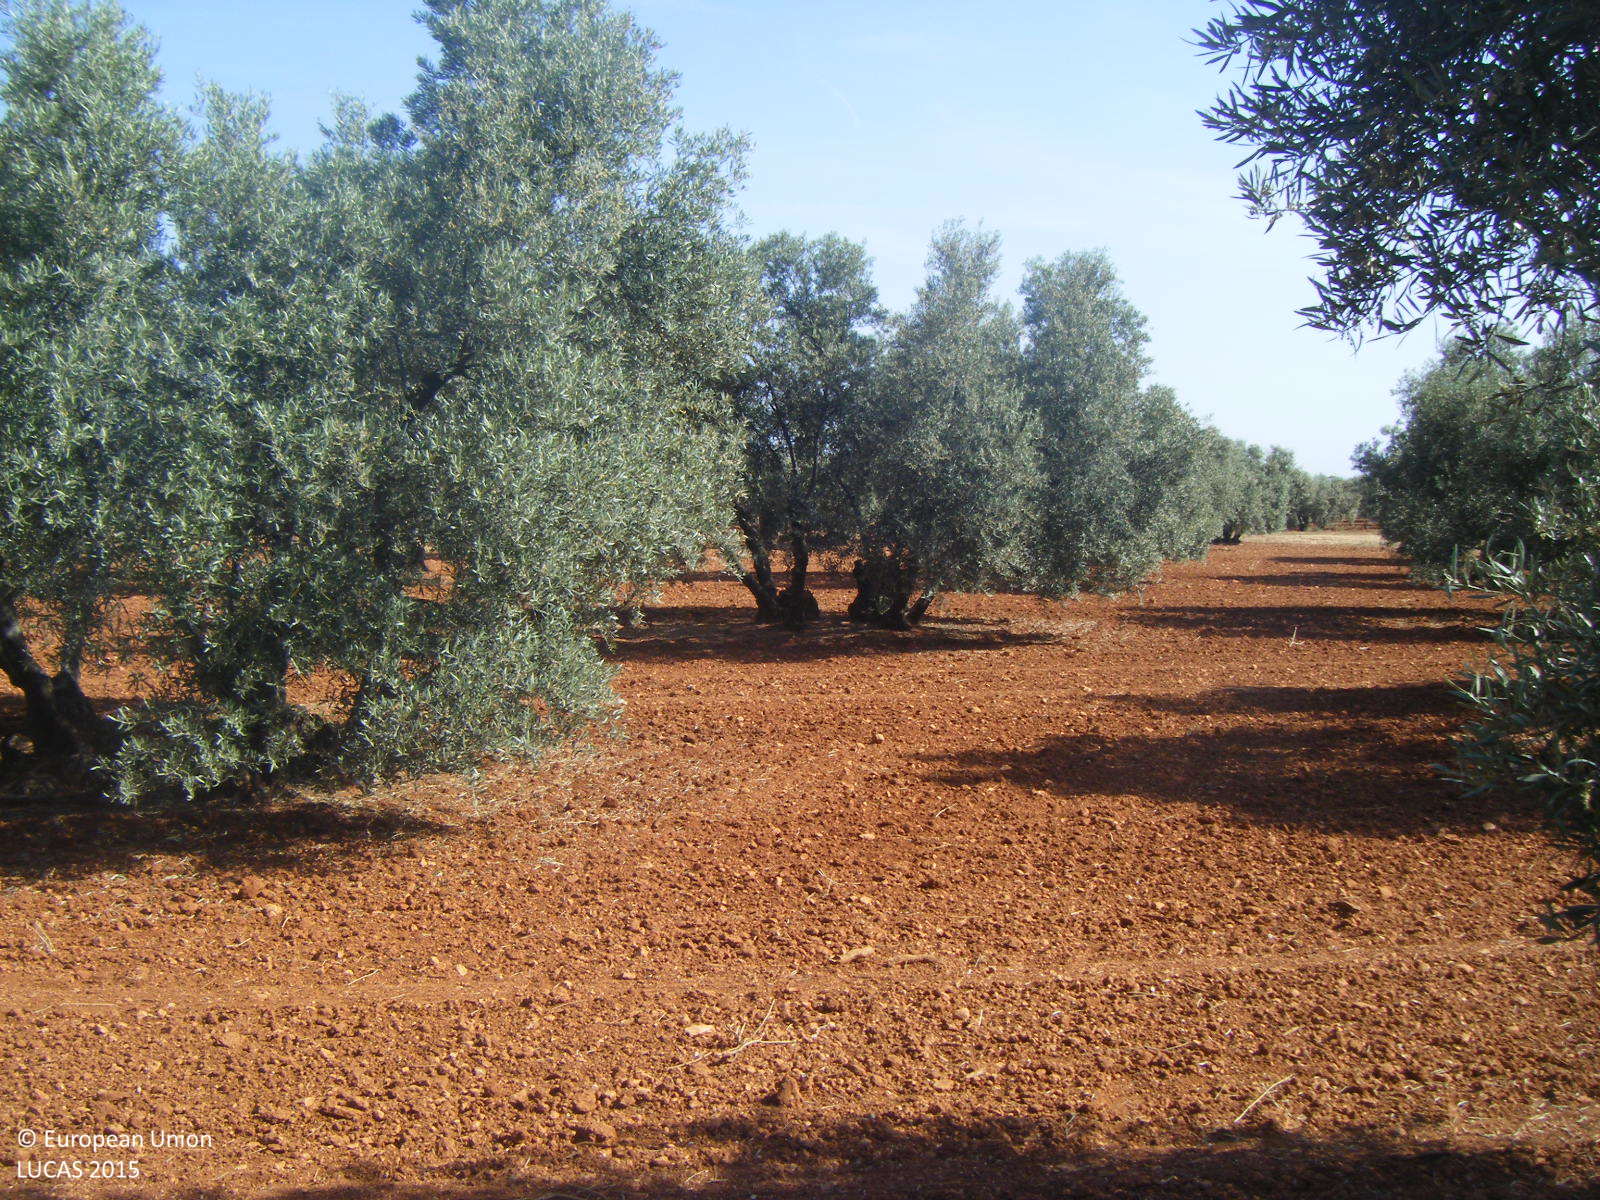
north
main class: Cropland
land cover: Olive groves
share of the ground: 25 - 50 %
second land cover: Other bare soil
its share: > 75 %
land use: Agriculture (excluding fallow land and kitchen gardens)
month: May
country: ES
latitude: 37.2298
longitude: -4.7794
